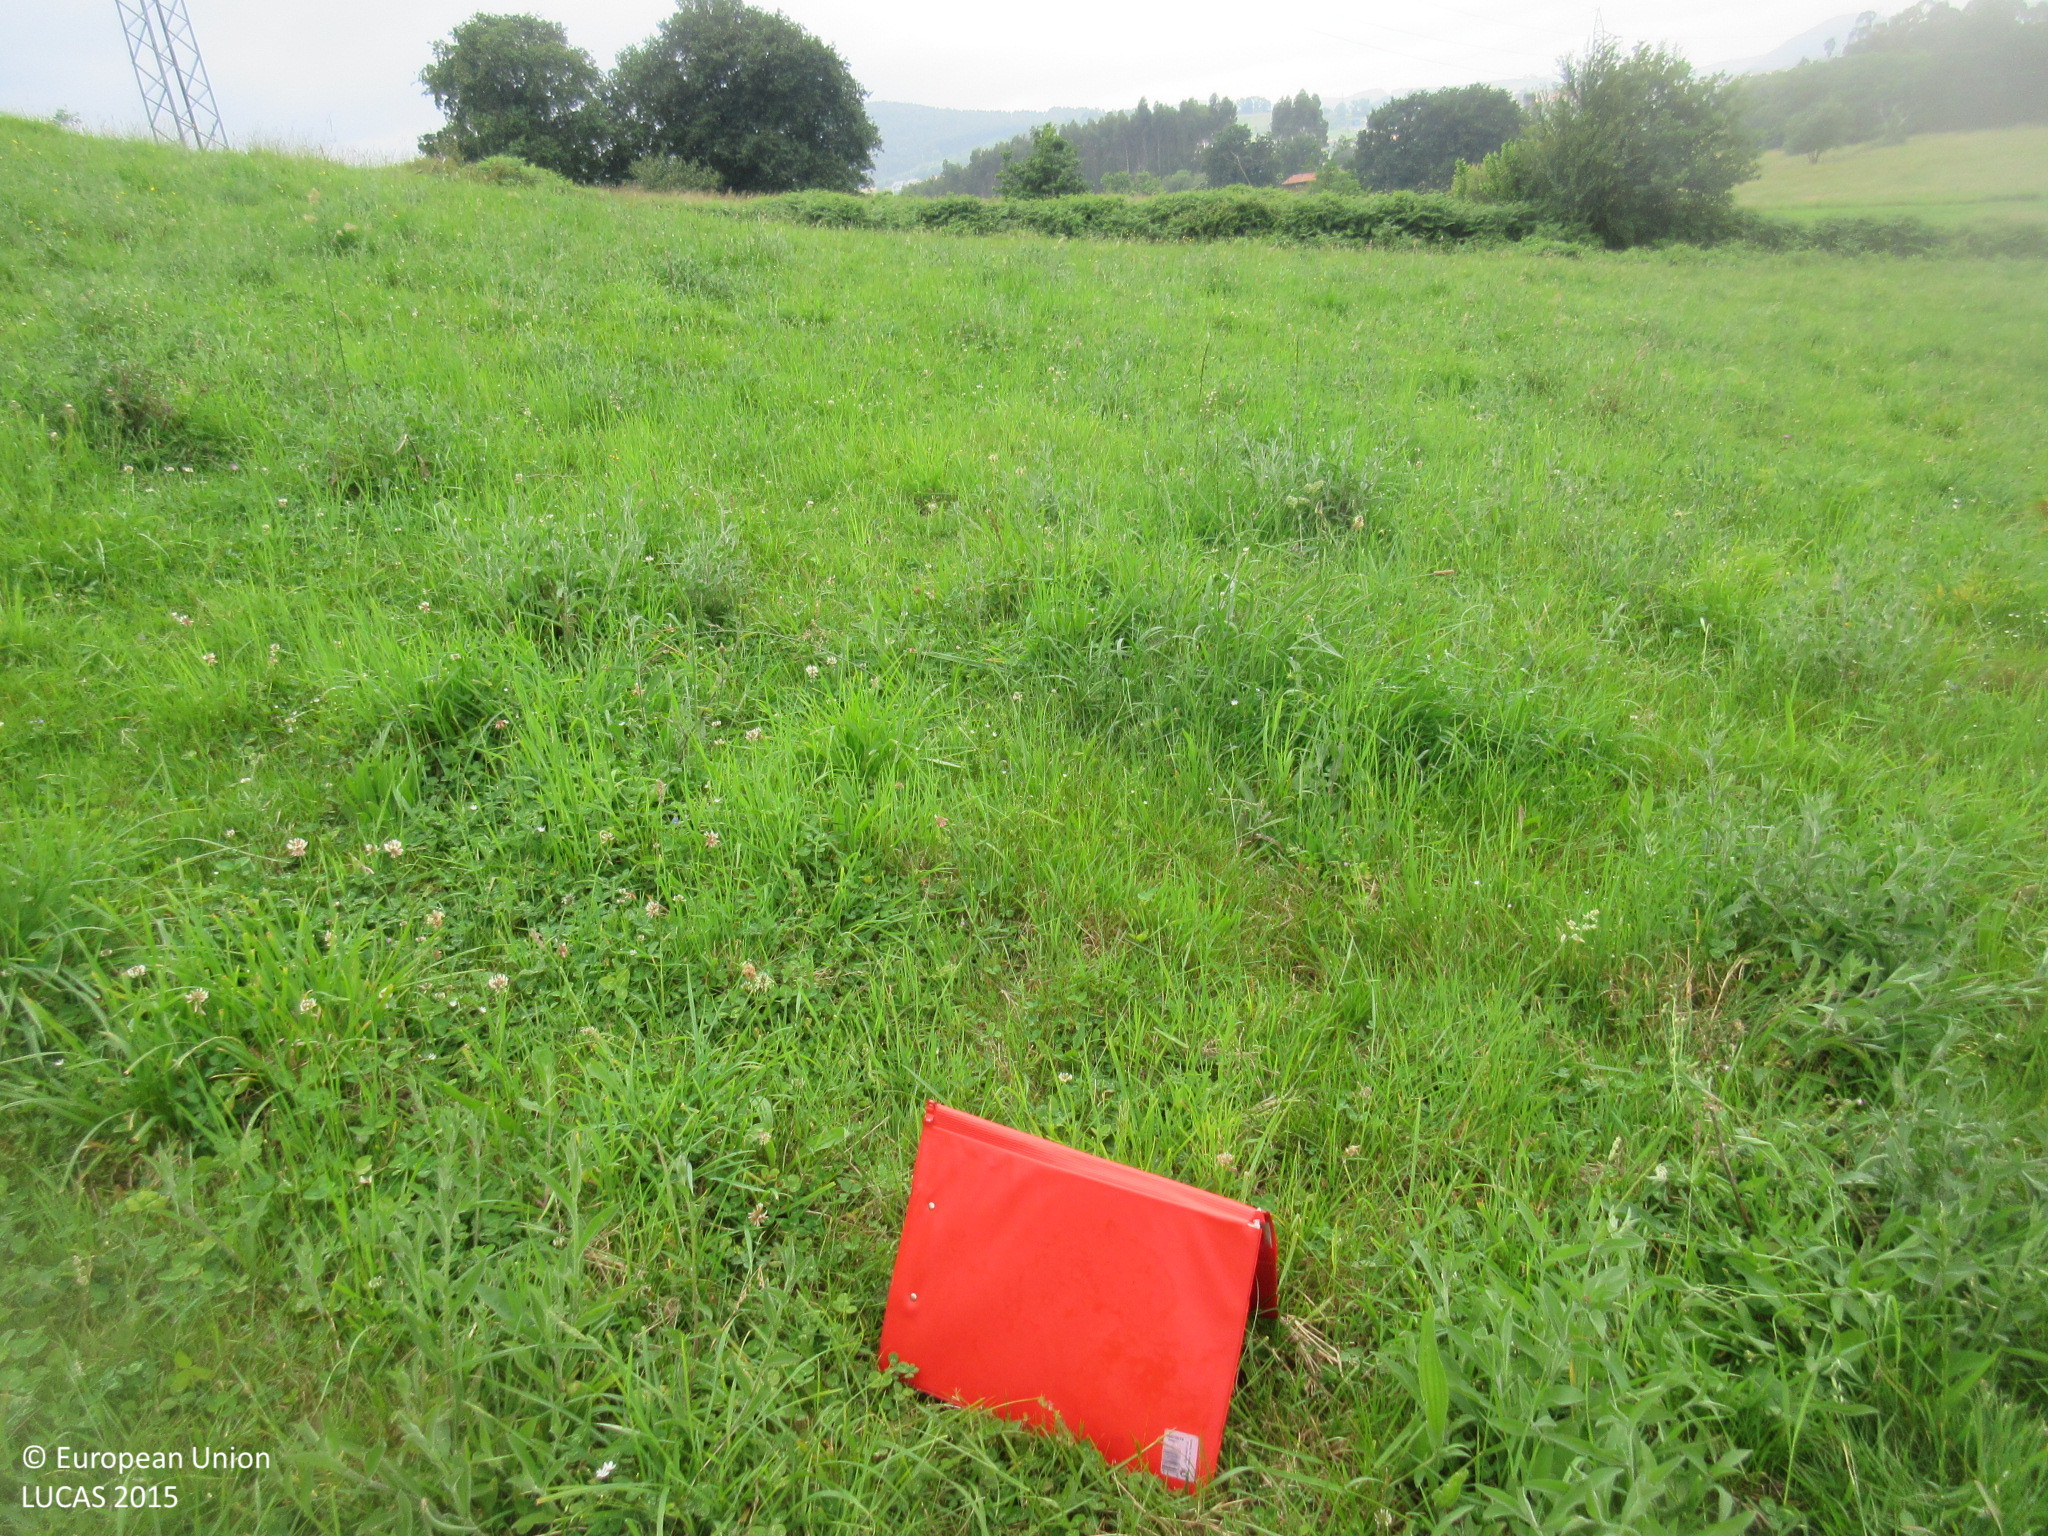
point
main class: Grassland
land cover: Grassland without tree/shrub cover
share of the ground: > 75 %
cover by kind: herbaceous plants 100 %
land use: Agriculture (excluding fallow land and kitchen gardens)
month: June
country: ES
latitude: 43.3778
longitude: -3.4593
